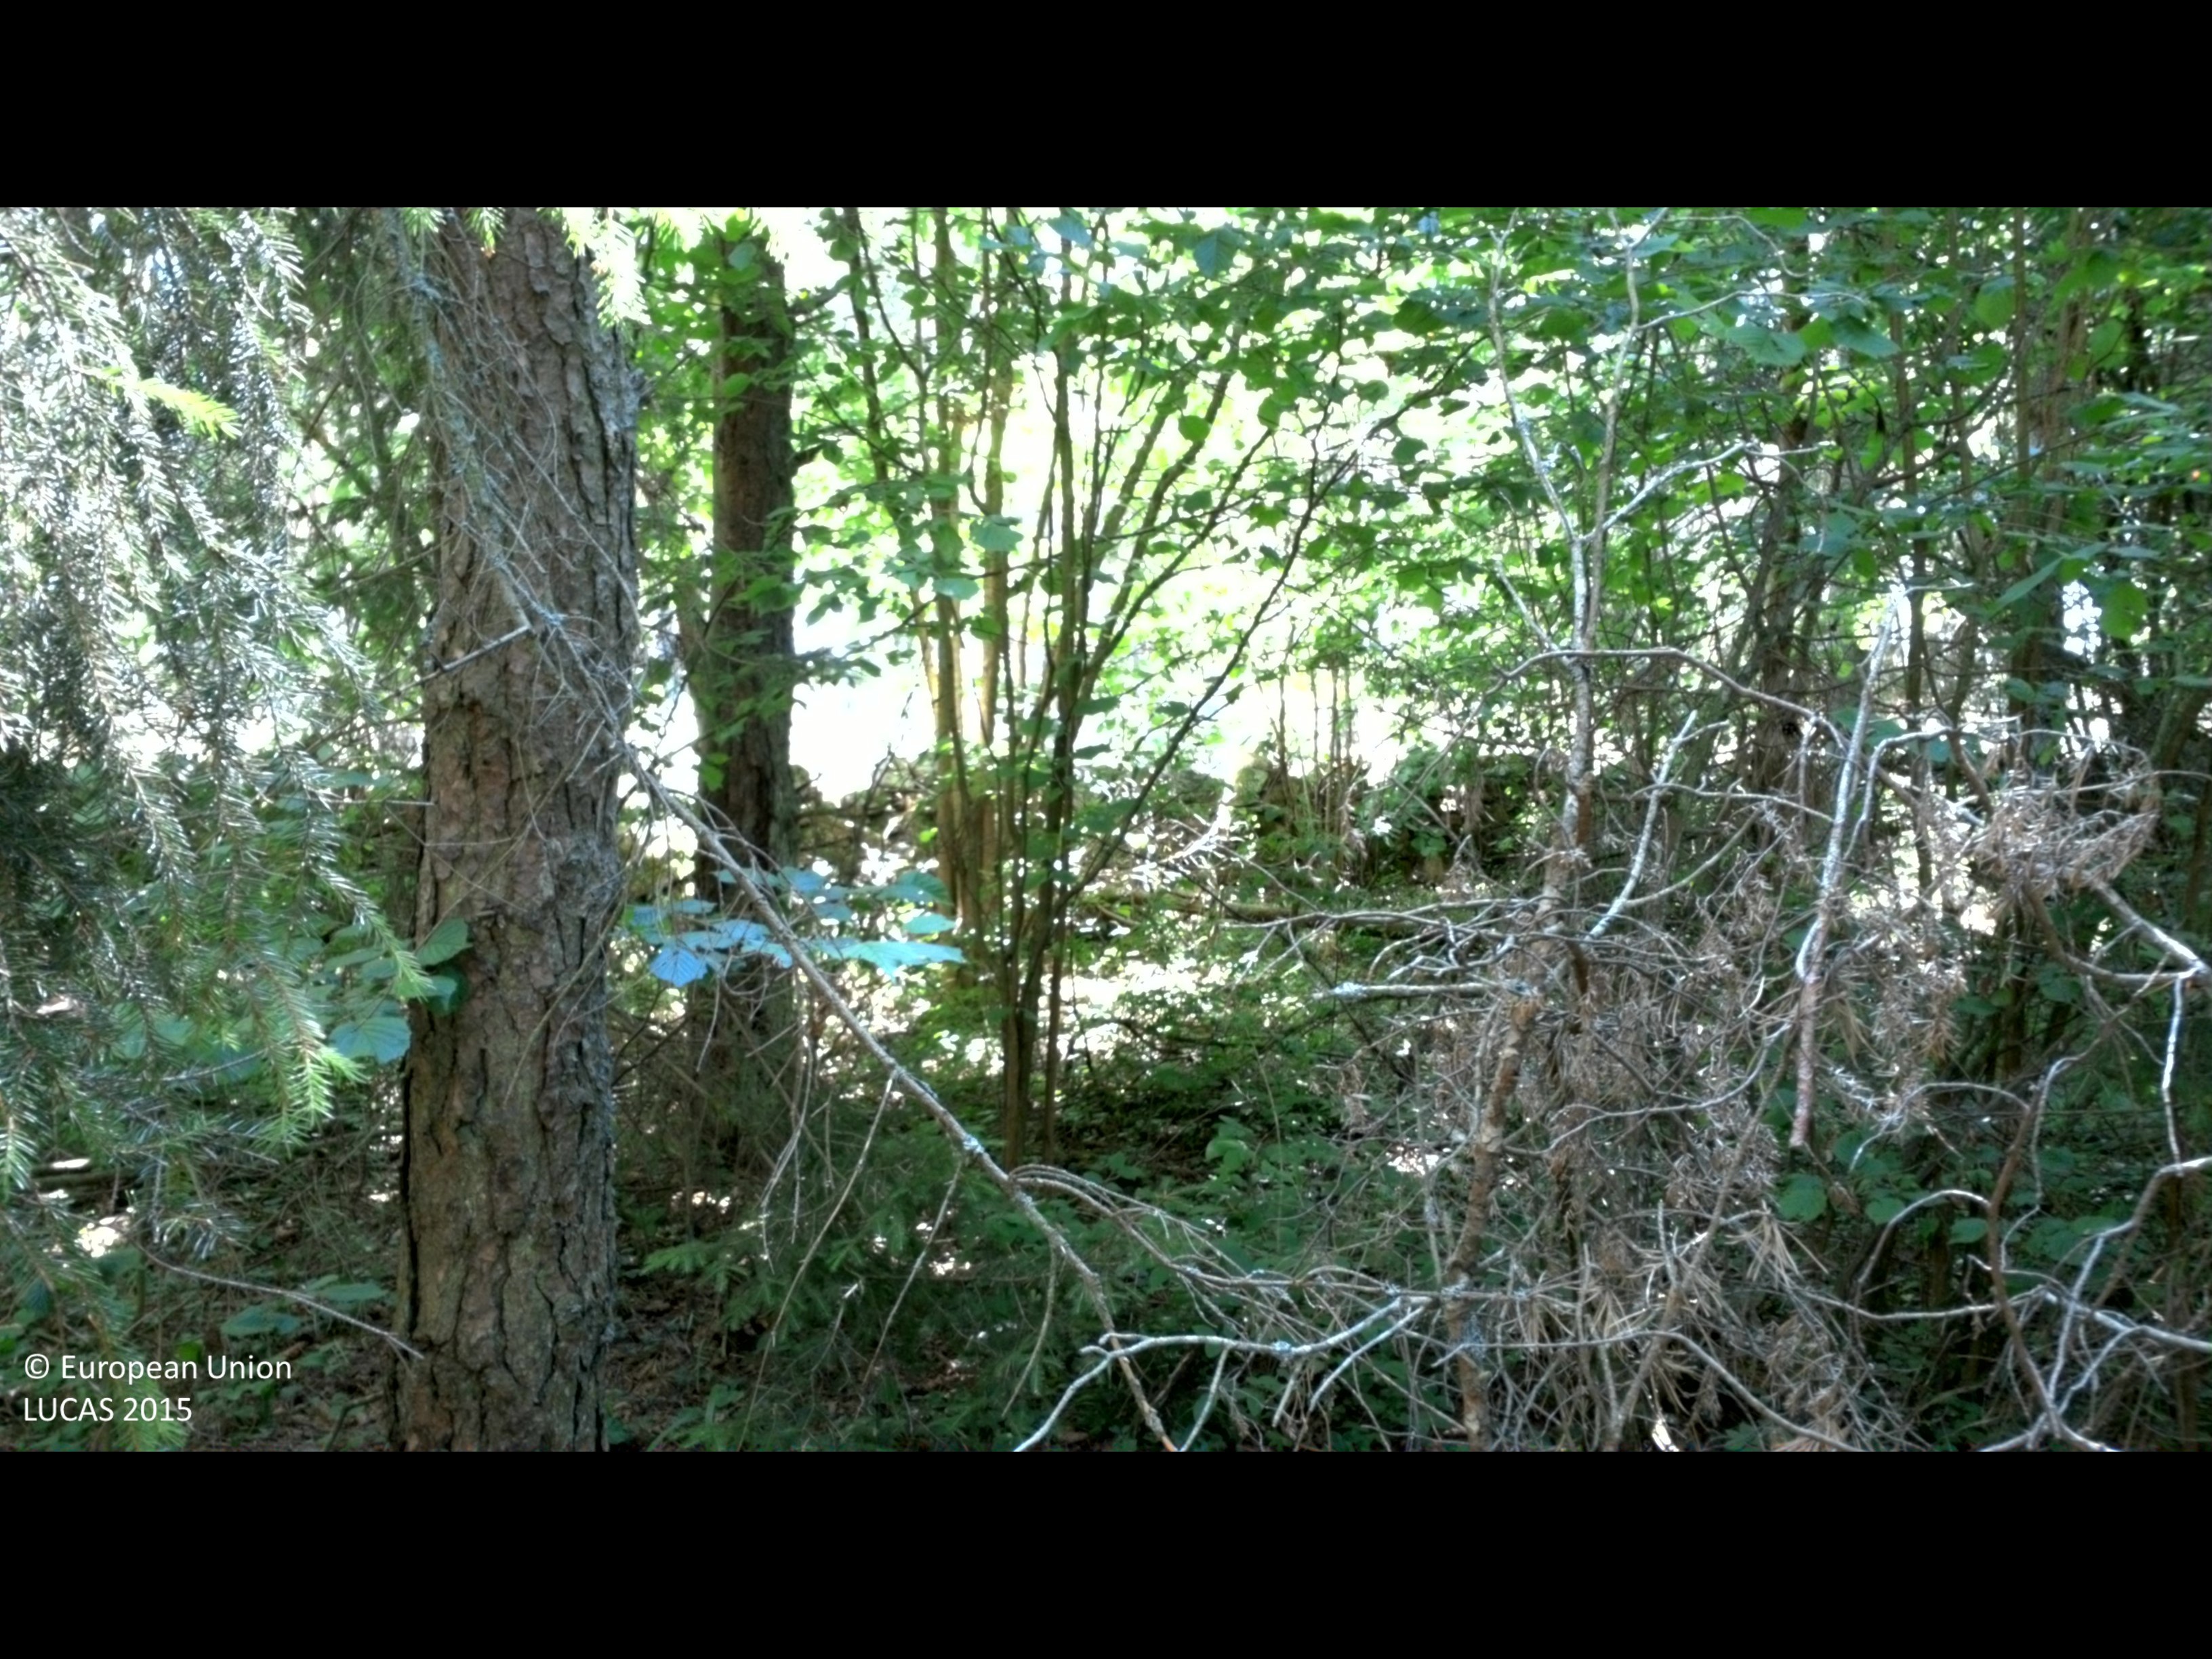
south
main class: Woodland
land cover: Pine dominated coniferous woodland
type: boreal forest
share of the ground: 50 - 75 %
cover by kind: coniferous forest trees 65 %, shrubs 30 %, herbaceous plants 5 %
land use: Forestry
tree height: > 5 m
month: July
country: SE
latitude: 56.5954
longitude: 16.5978
